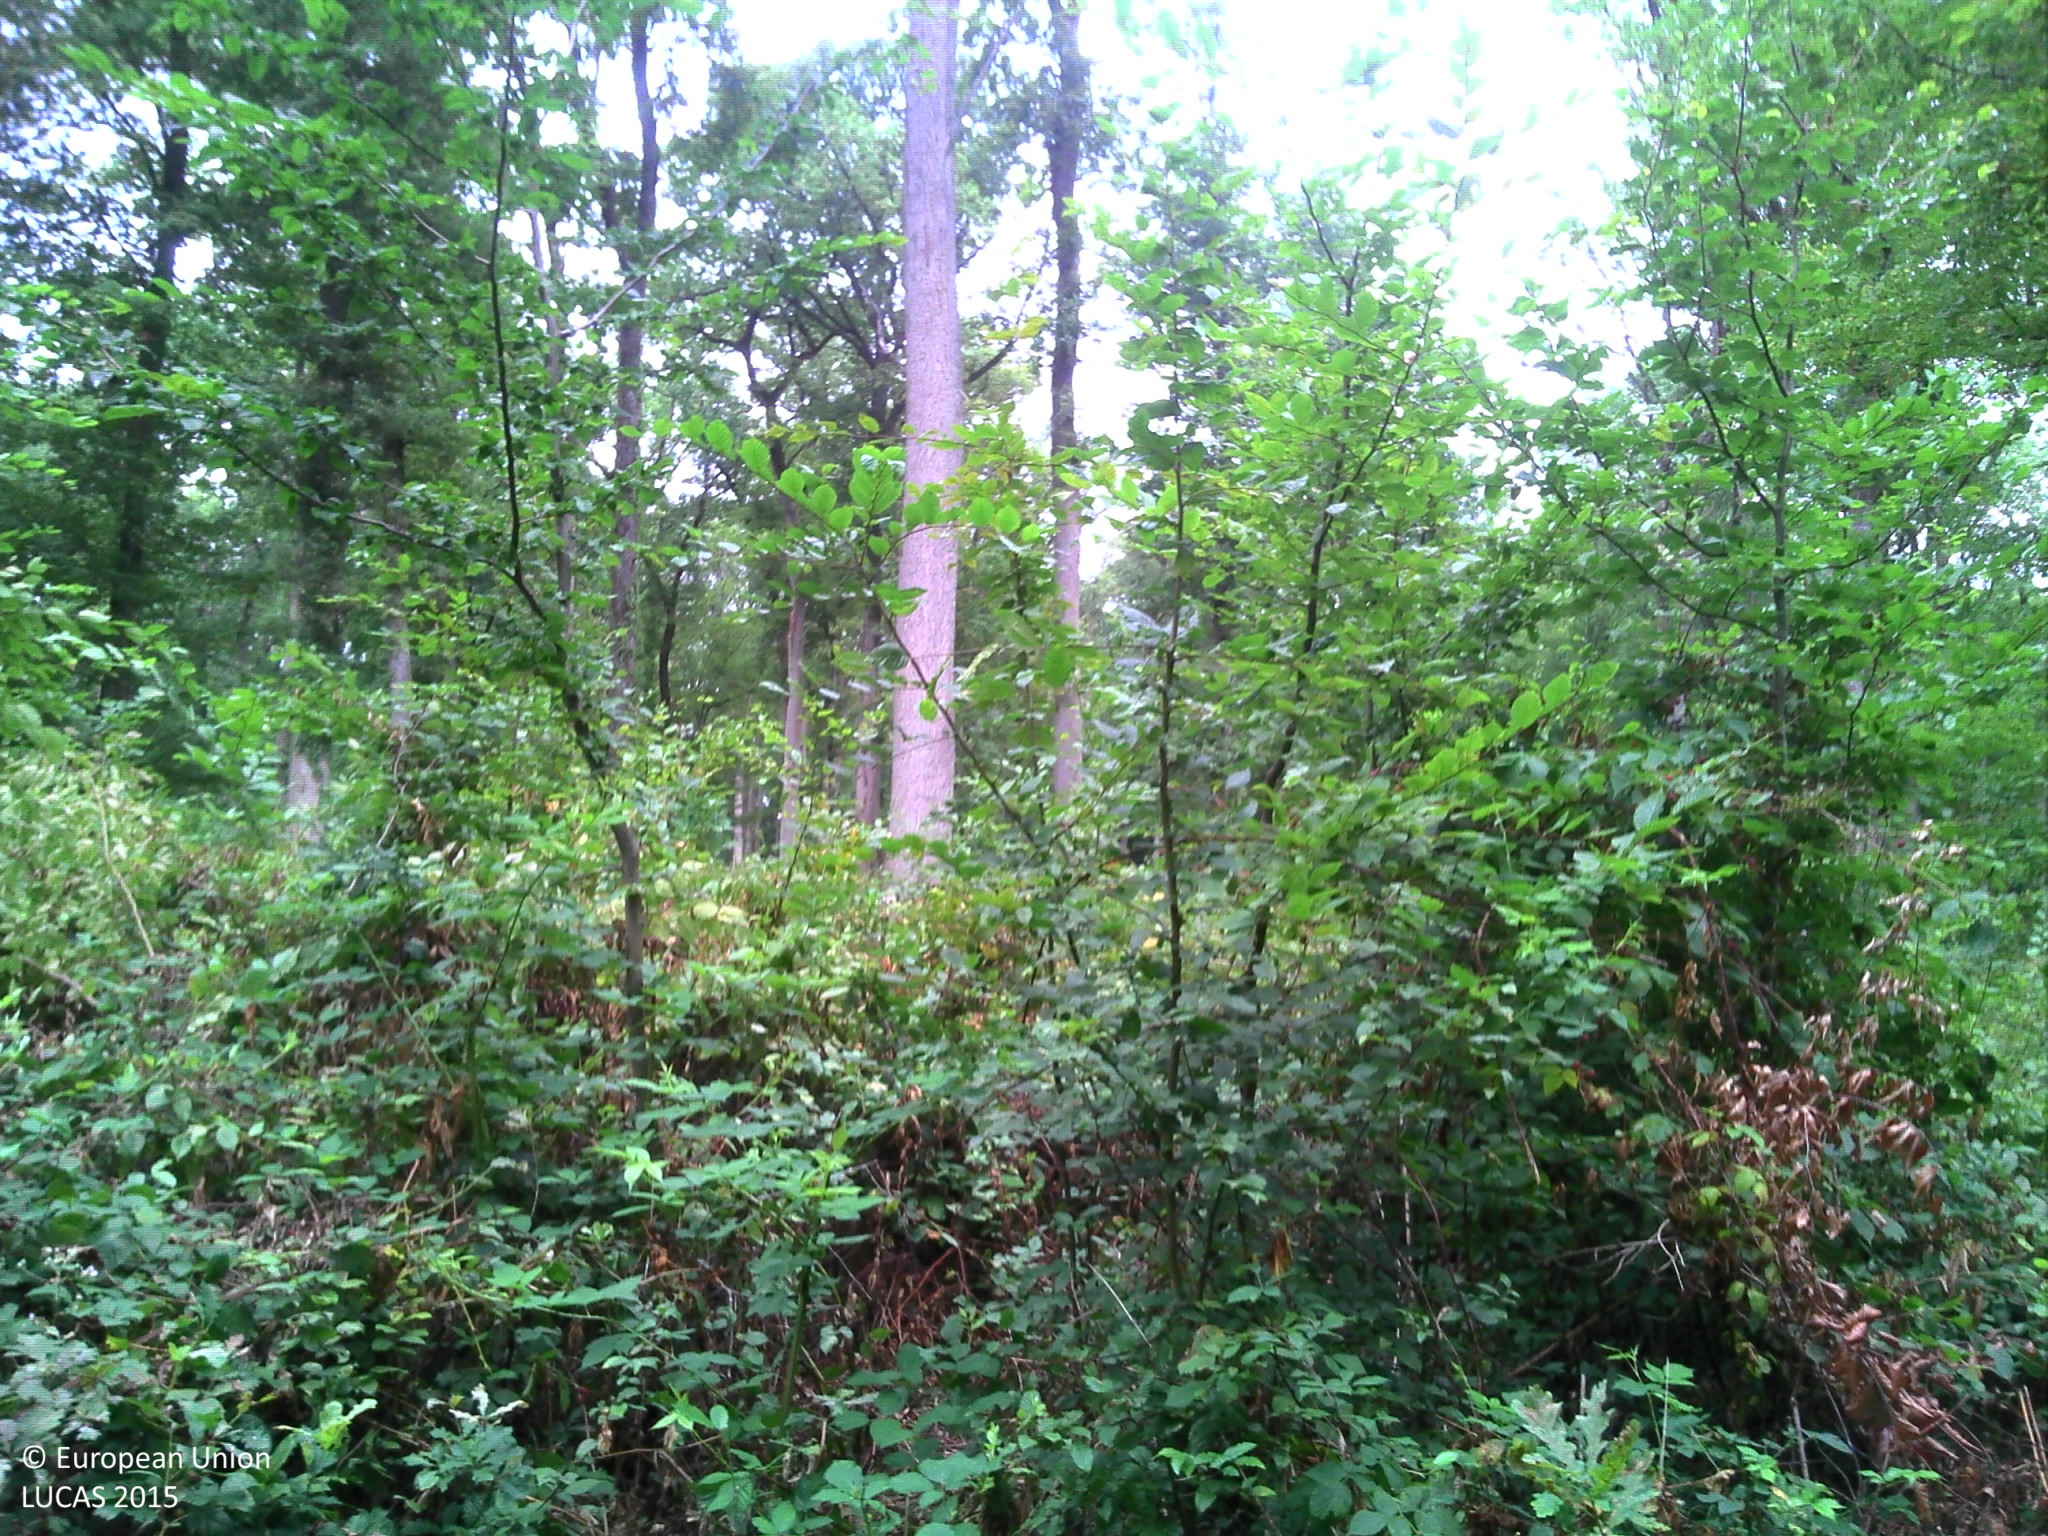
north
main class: Woodland
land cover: Broadleaved woodland
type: mesophytic deciduous forest
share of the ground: > 75 %
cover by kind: broadleaved forest trees 80 %, herbaceous plants 20 %
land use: Forestry
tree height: > 5 m
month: August
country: FR
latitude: 48.8835
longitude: 7.6960
